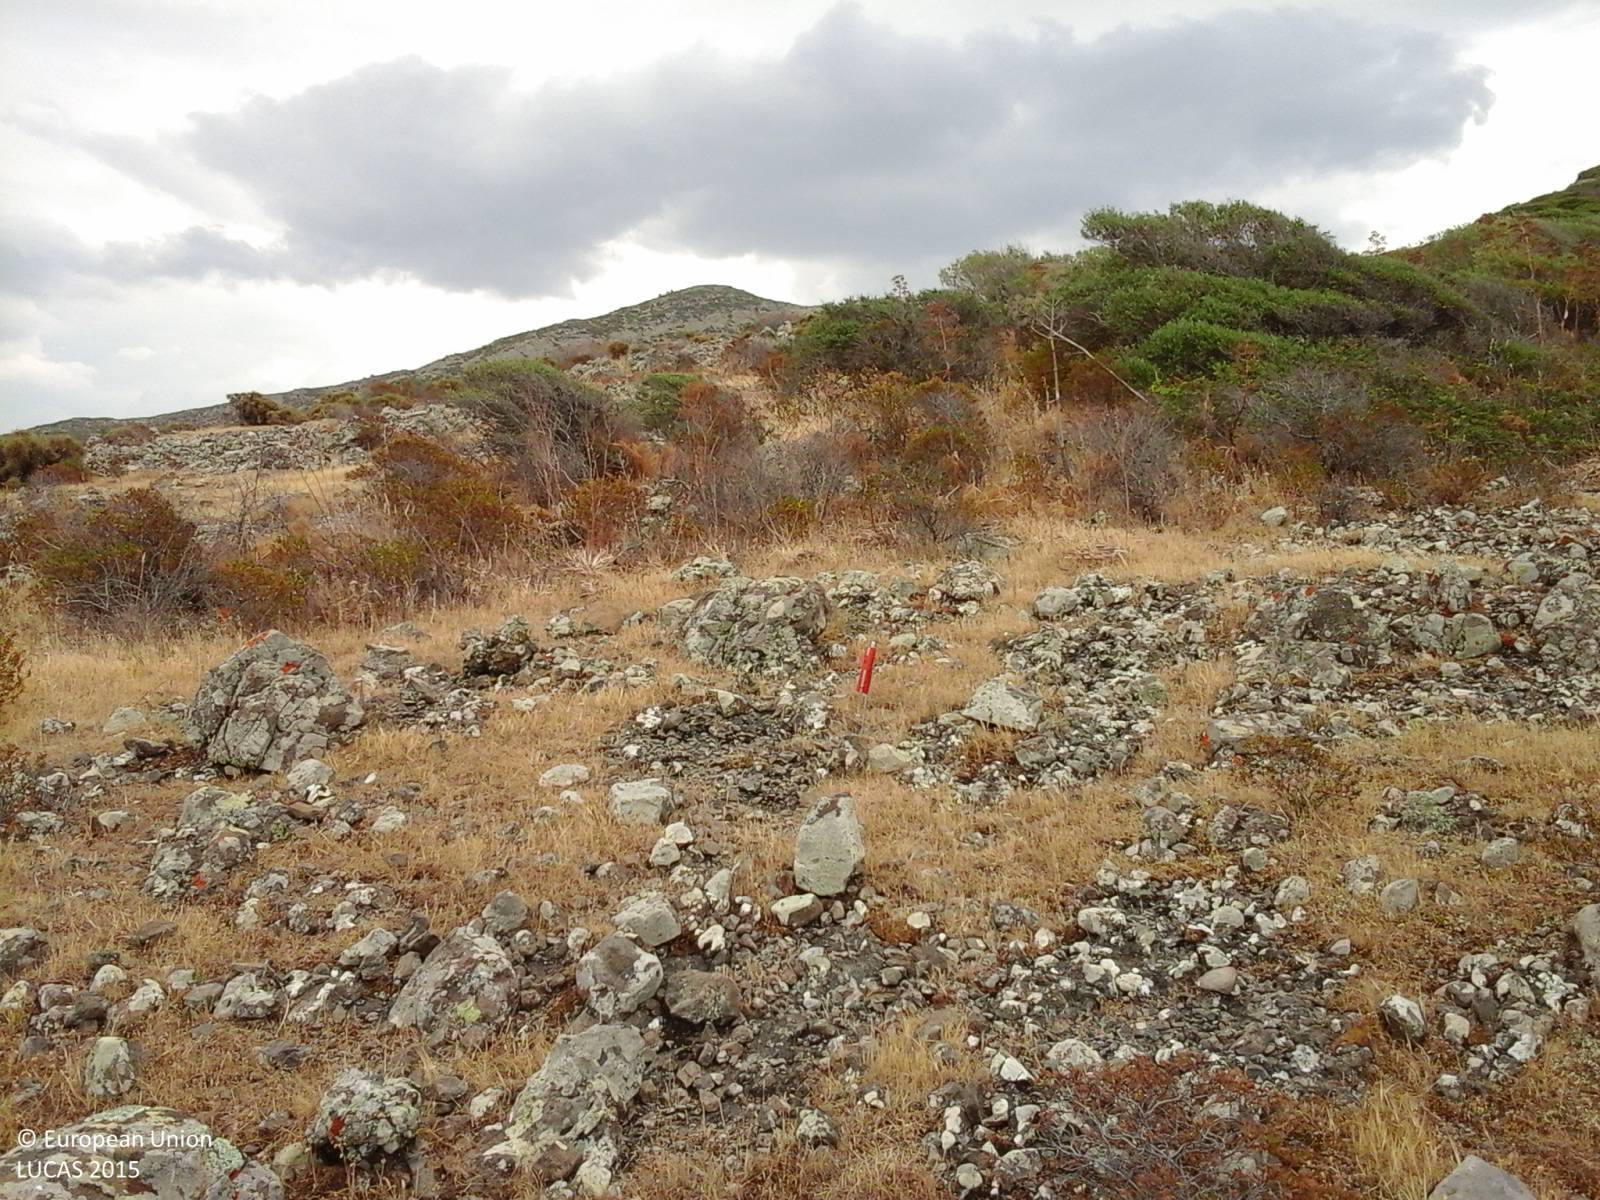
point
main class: Shrubland
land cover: Shrubland without tree cover
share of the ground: 50 - 75 %
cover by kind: consolidated bare surface 50 %, herbaceous plants 30 %, shrubs 20 %
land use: Semi-natural and natural areas not in use
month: June
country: IT
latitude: 39.6771
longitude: 8.5510
